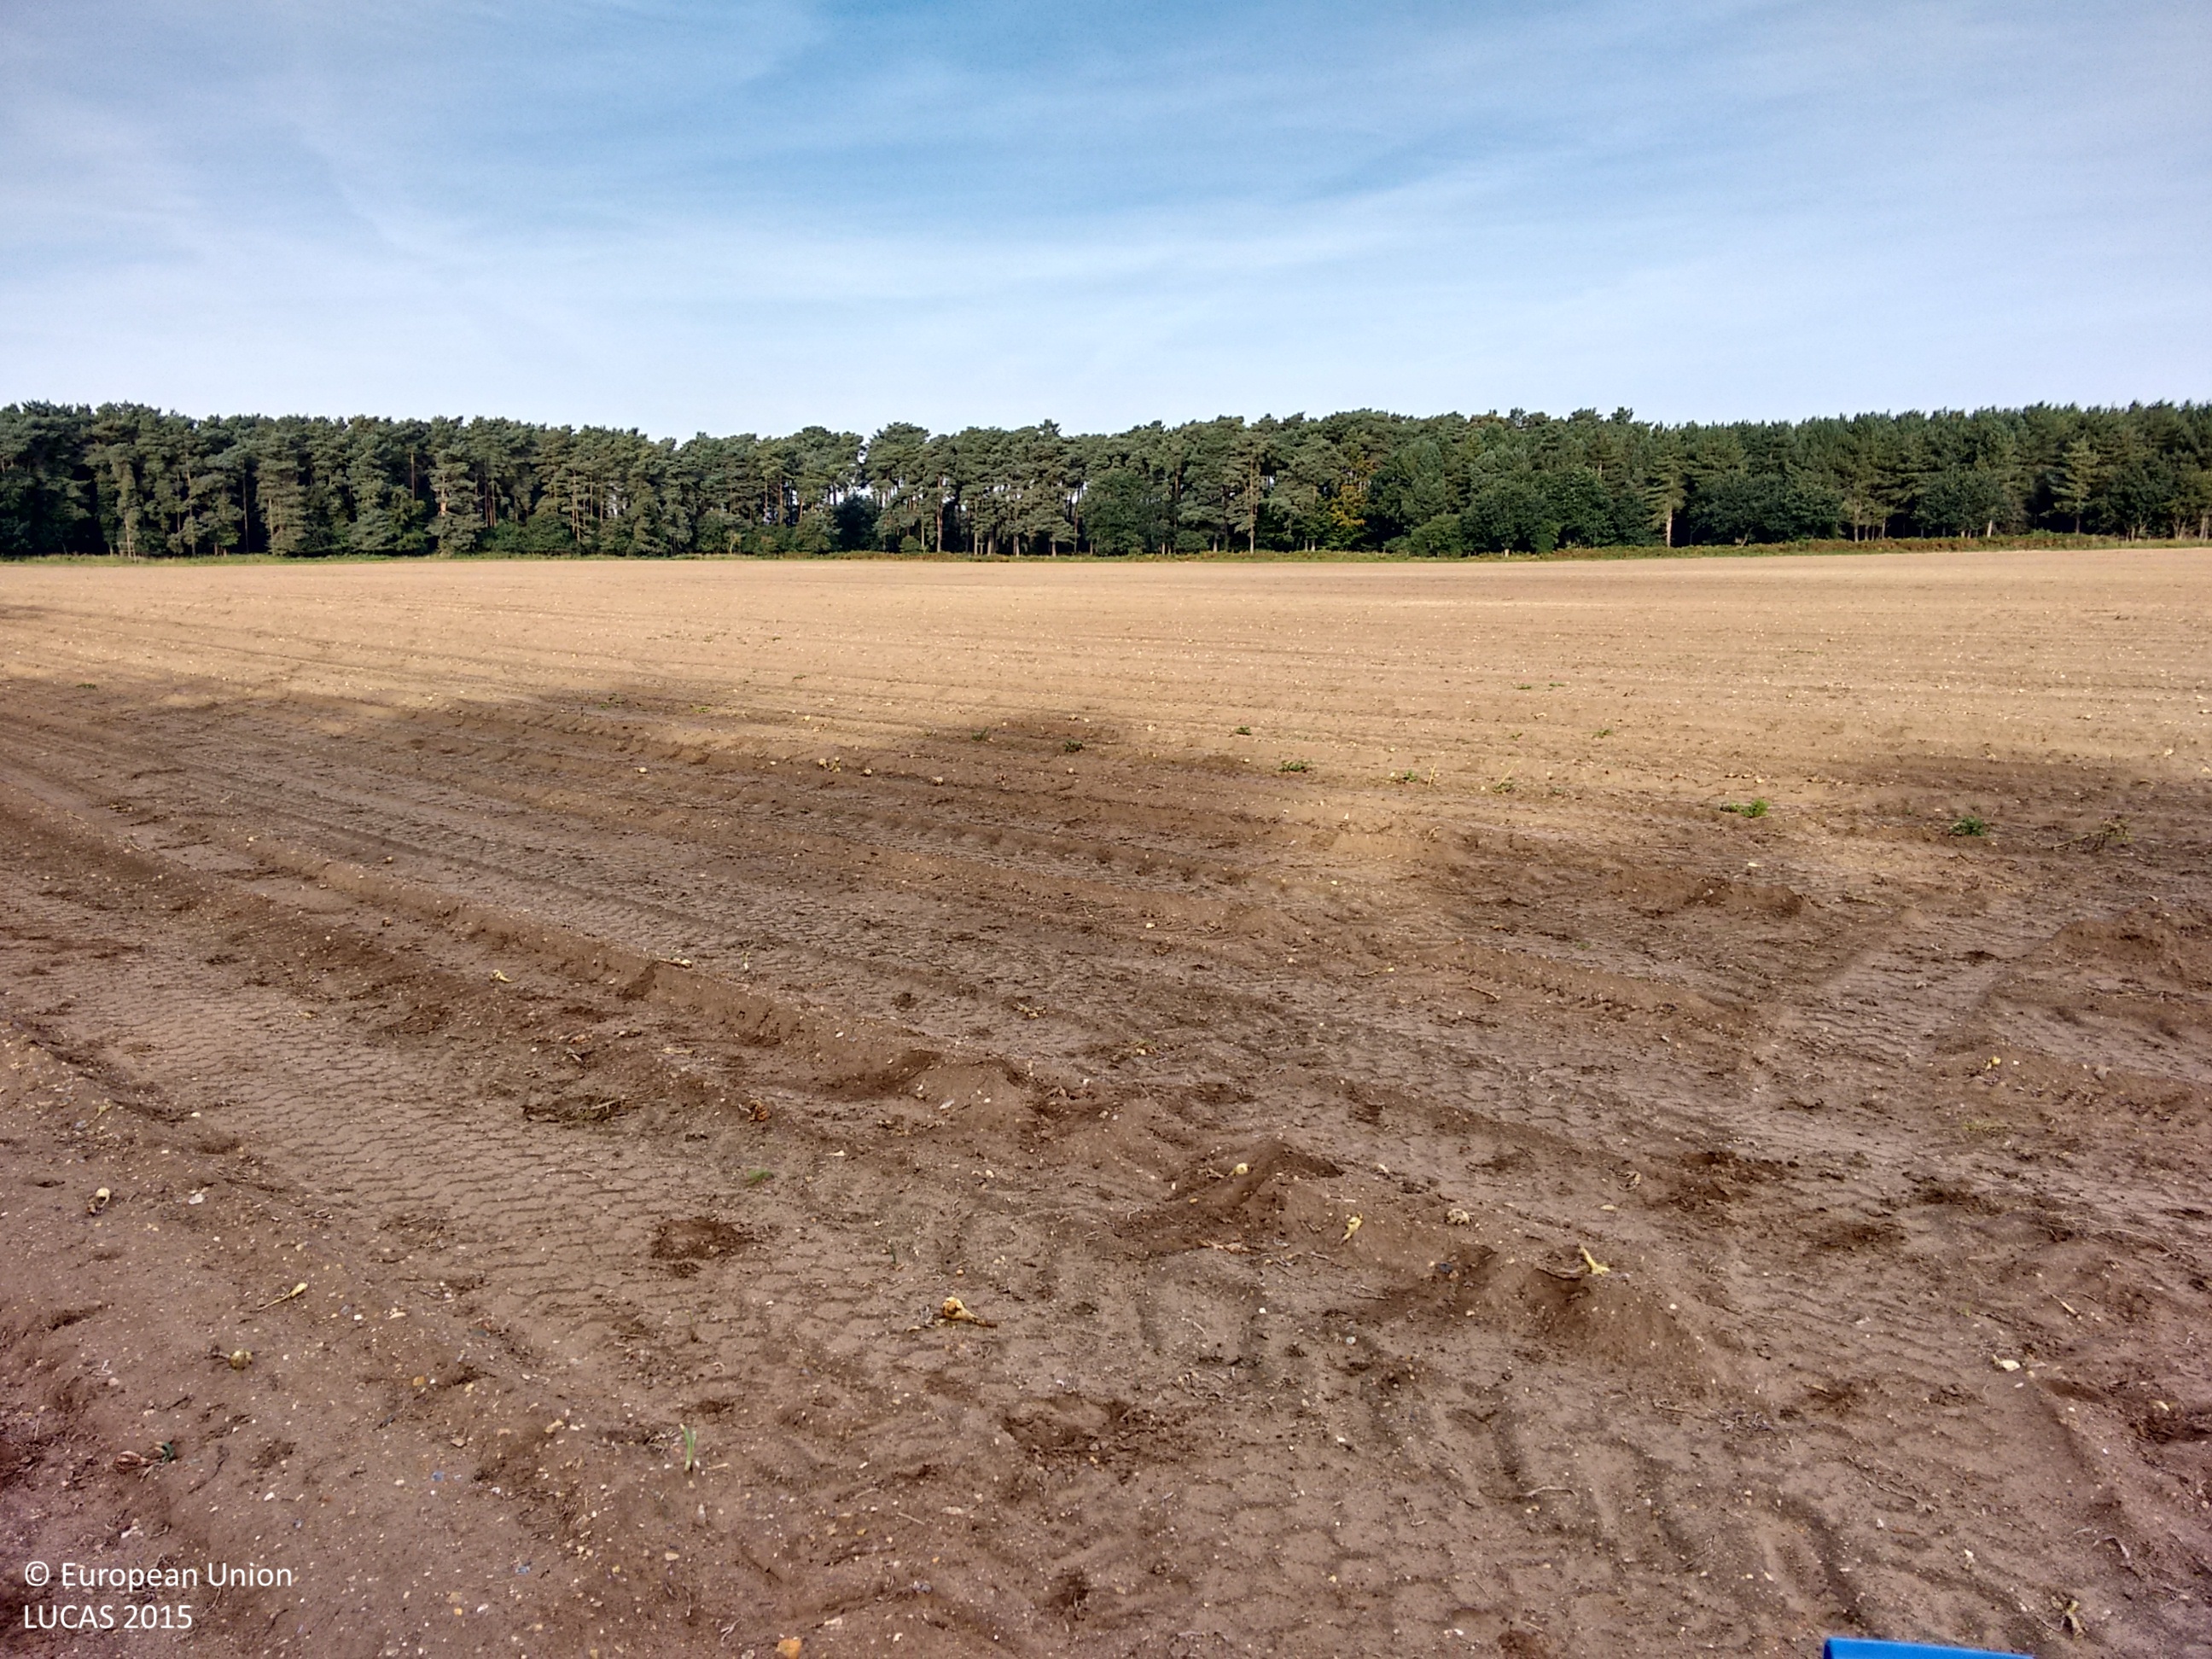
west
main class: Cropland
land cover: Other root crops
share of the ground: > 75 %
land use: Agriculture (excluding fallow land and kitchen gardens)
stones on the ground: < 10 %
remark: Harvested field
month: September
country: GB
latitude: 52.4056
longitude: 0.8770
